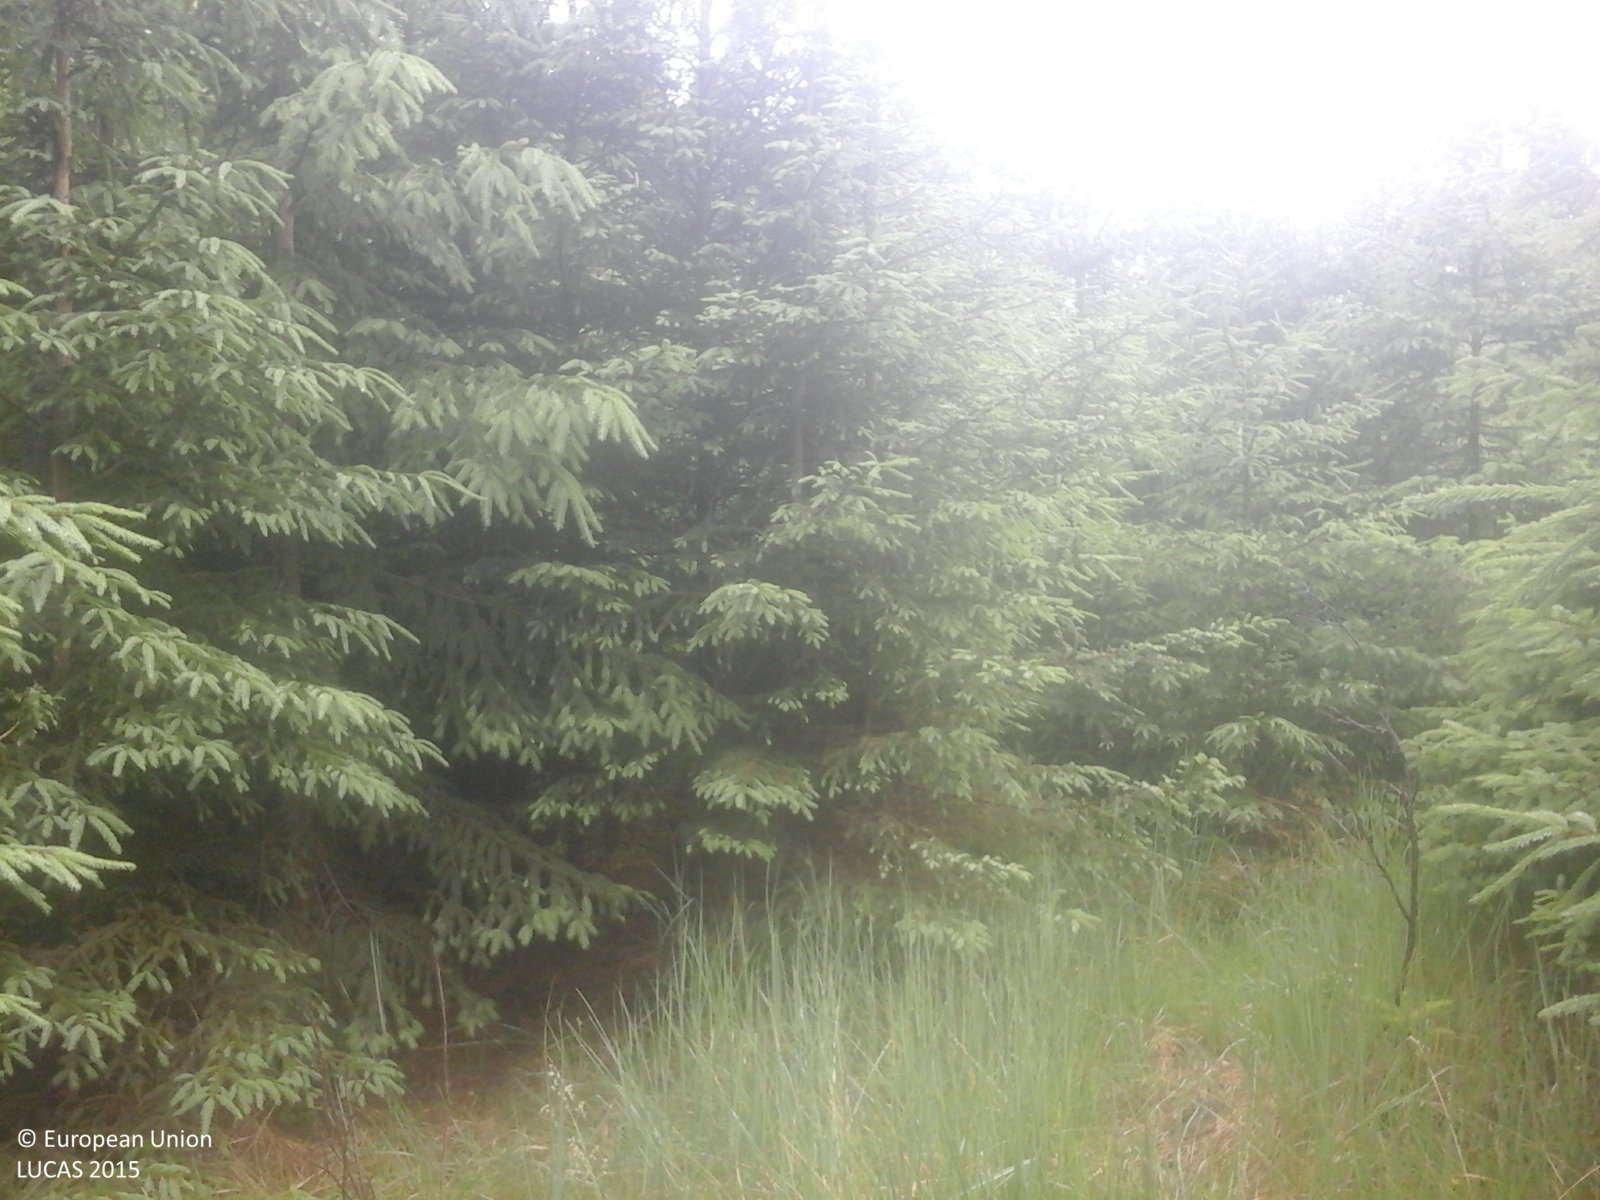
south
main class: Woodland
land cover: Spruce dominated coniferous woodland
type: alpine coniferous forest
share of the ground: > 75 %
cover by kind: coniferous forest trees 85 %, herbaceous plants 15 %
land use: Forestry
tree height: > 5 m
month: June
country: RO
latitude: 47.5351
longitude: 25.7853
